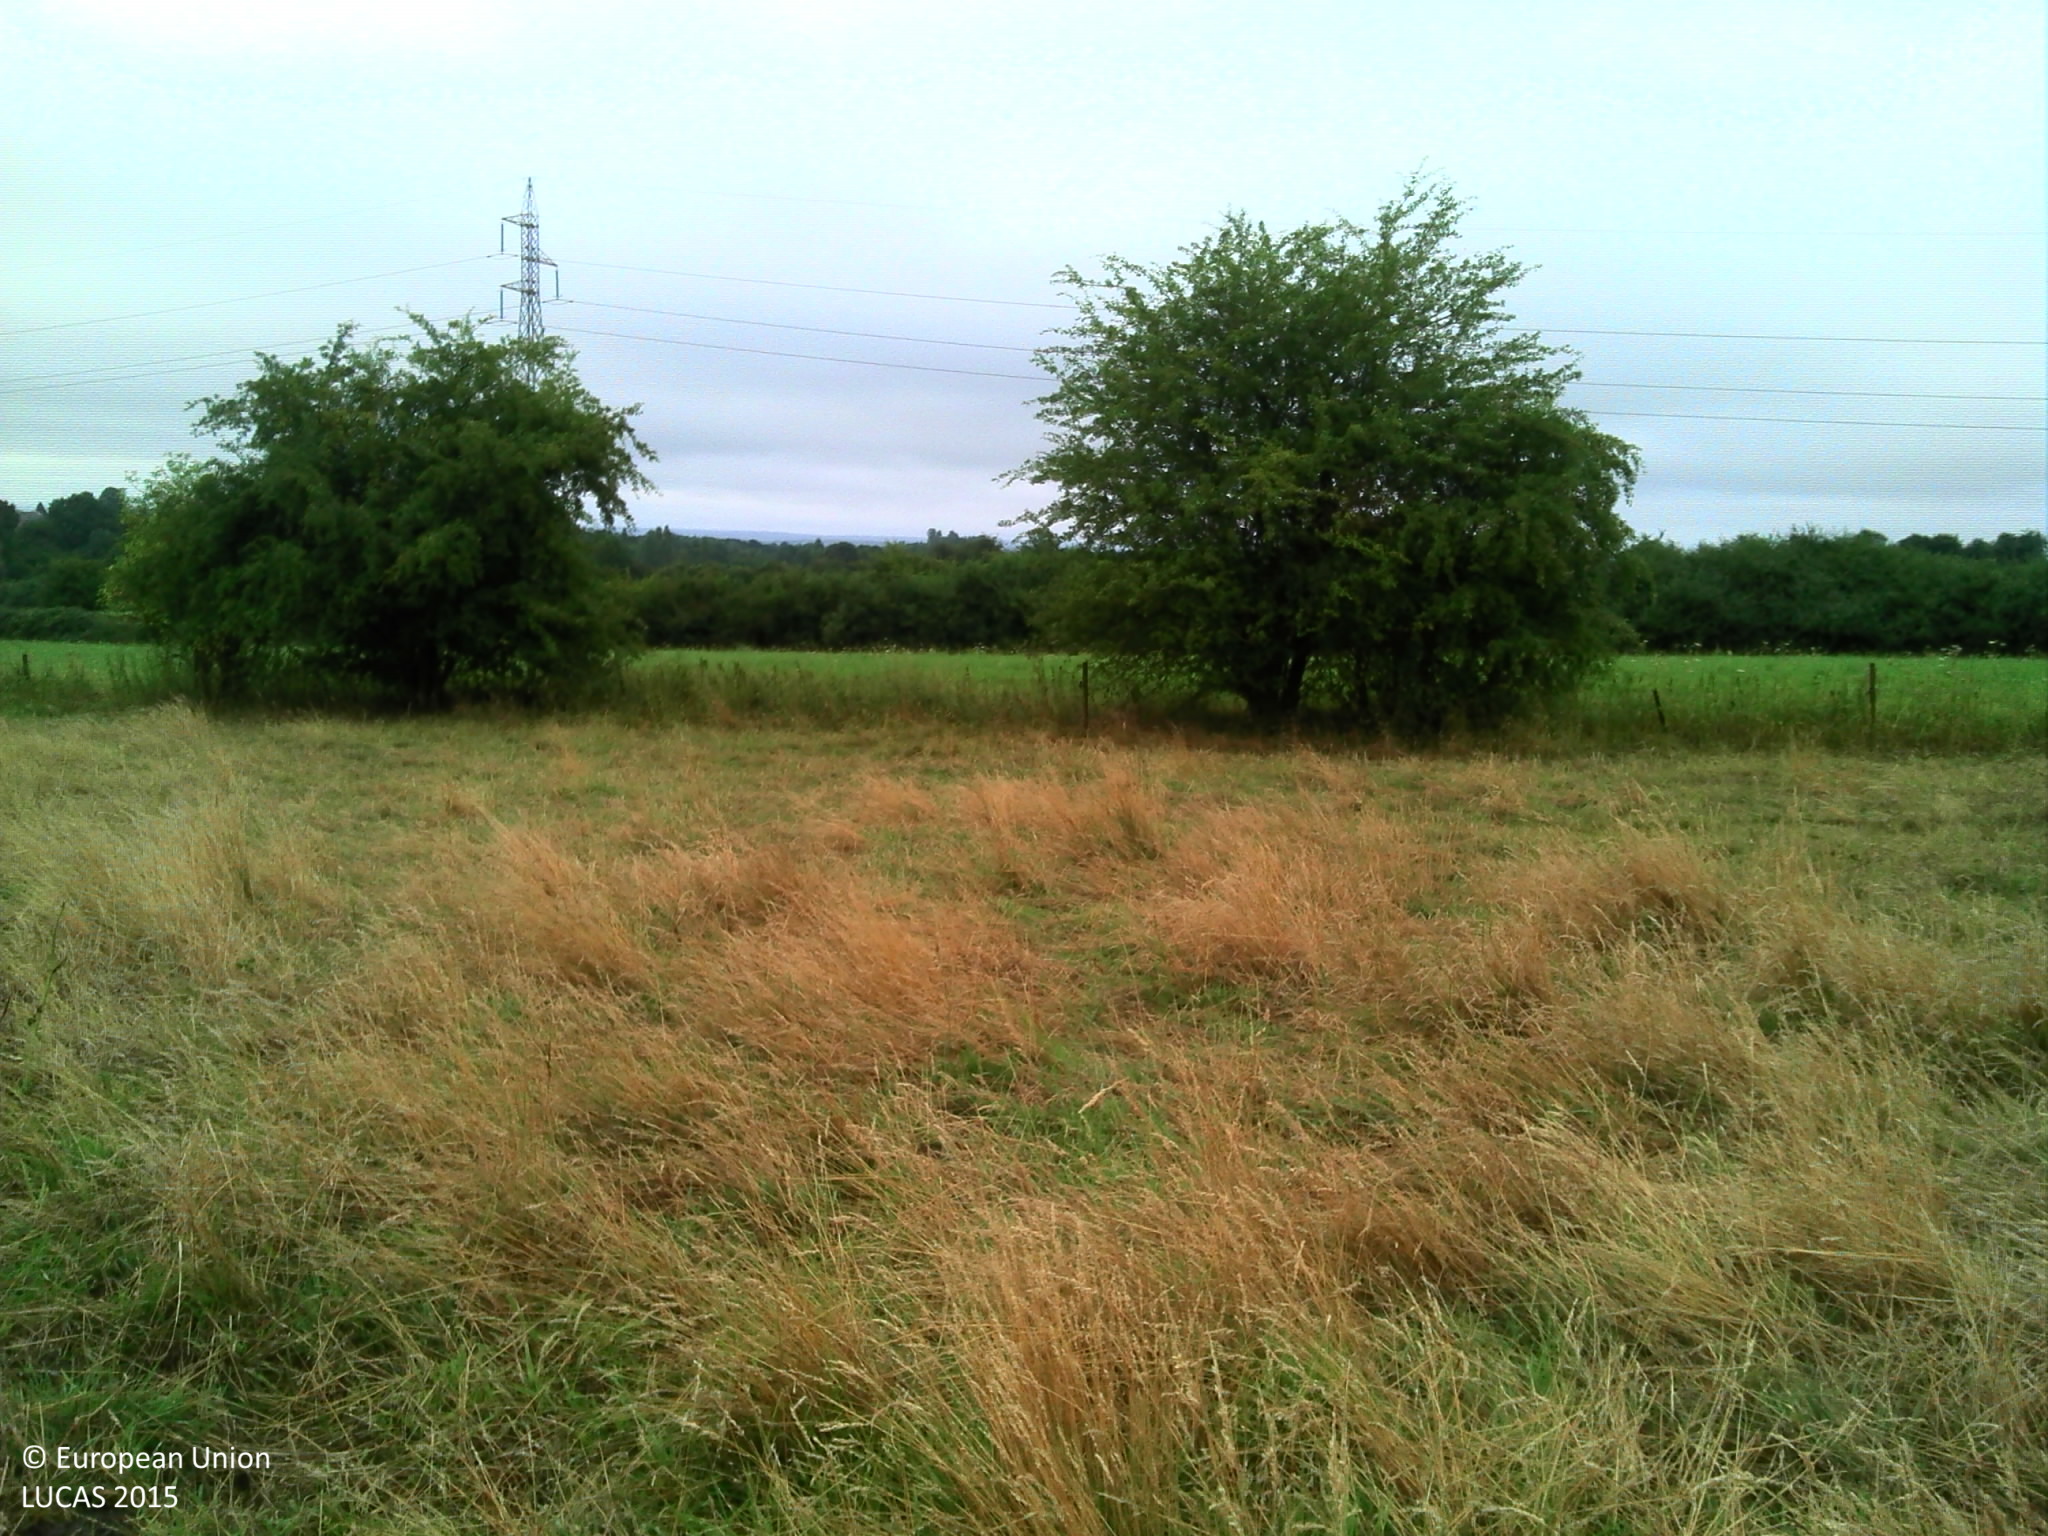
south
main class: Grassland
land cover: Grassland without tree/shrub cover
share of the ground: > 75 %
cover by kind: herbaceous plants 100 %
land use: Agriculture (excluding fallow land and kitchen gardens)
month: July
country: BE
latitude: 50.2006
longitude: 4.6025
